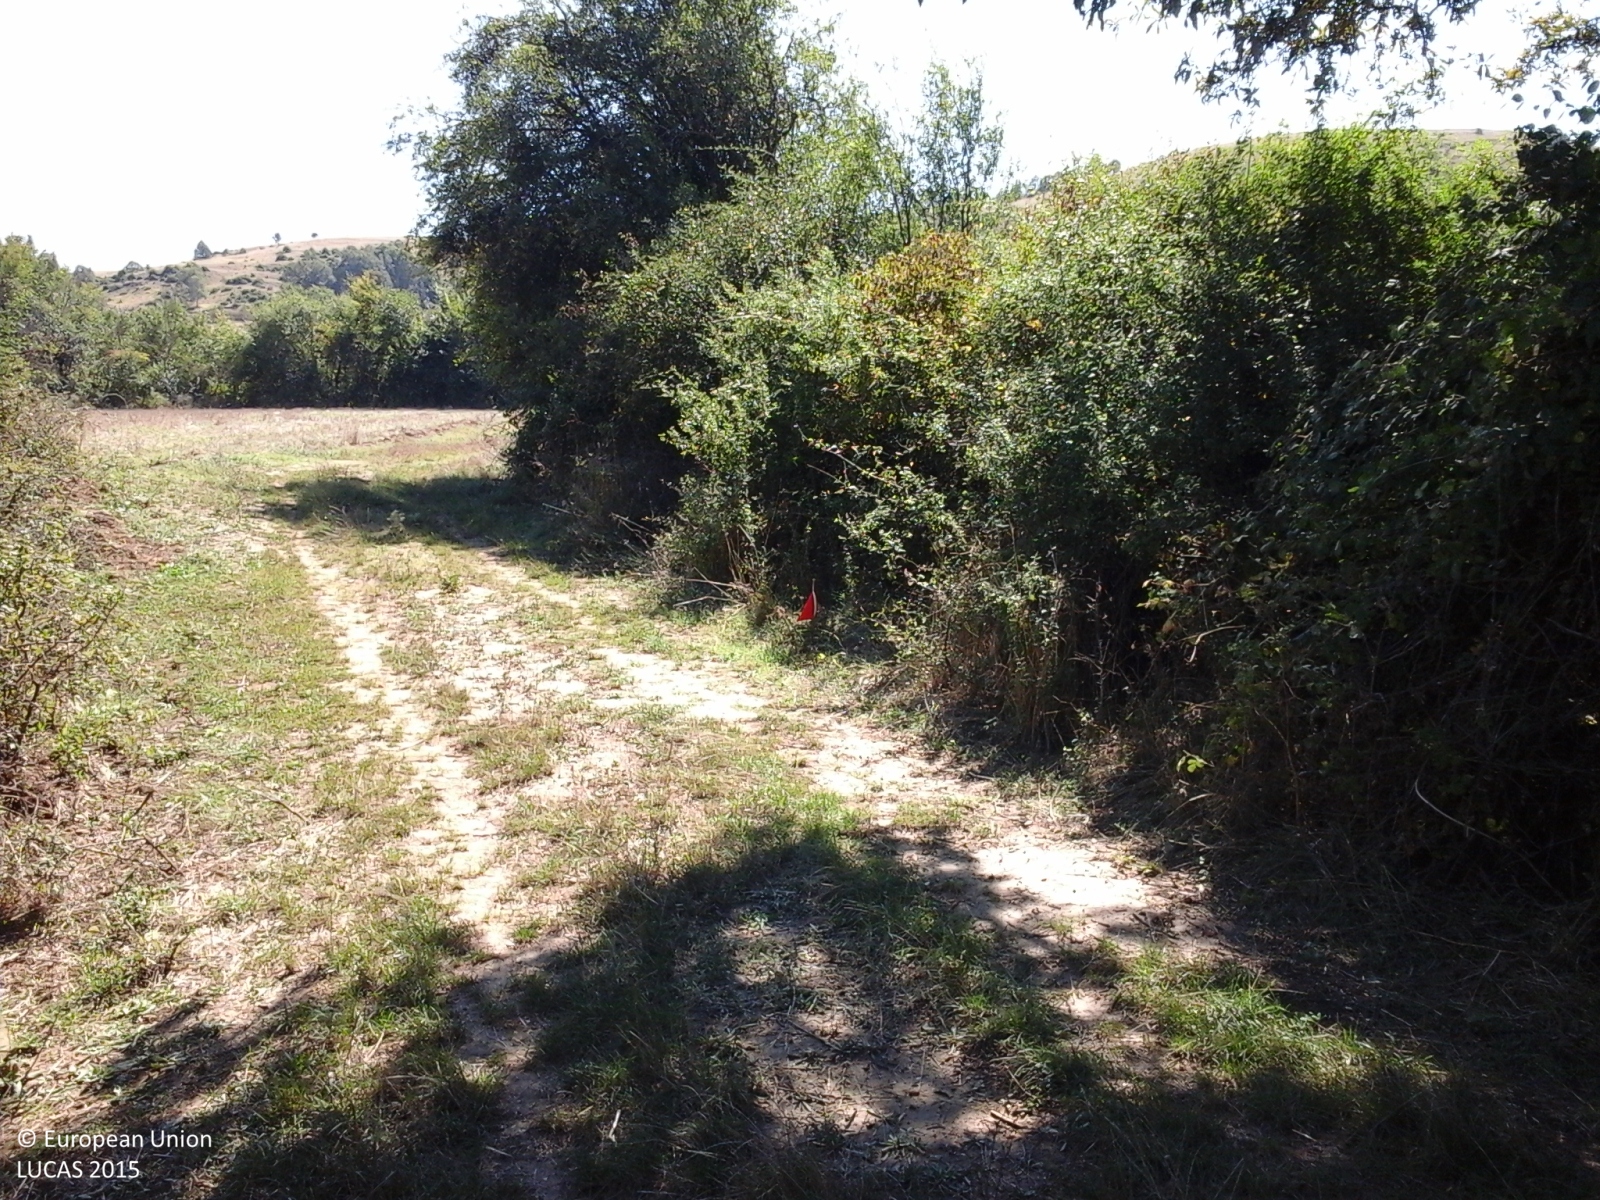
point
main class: Woodland
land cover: Broadleaved woodland
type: thermophilous deciduous forest
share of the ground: 50 - 75 %
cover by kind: broadleaved forest trees 70 %, shrubs 30 %
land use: Semi-natural and natural areas not in use
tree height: > 5 m
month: September
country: GR
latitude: 40.3930
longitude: 21.3344
